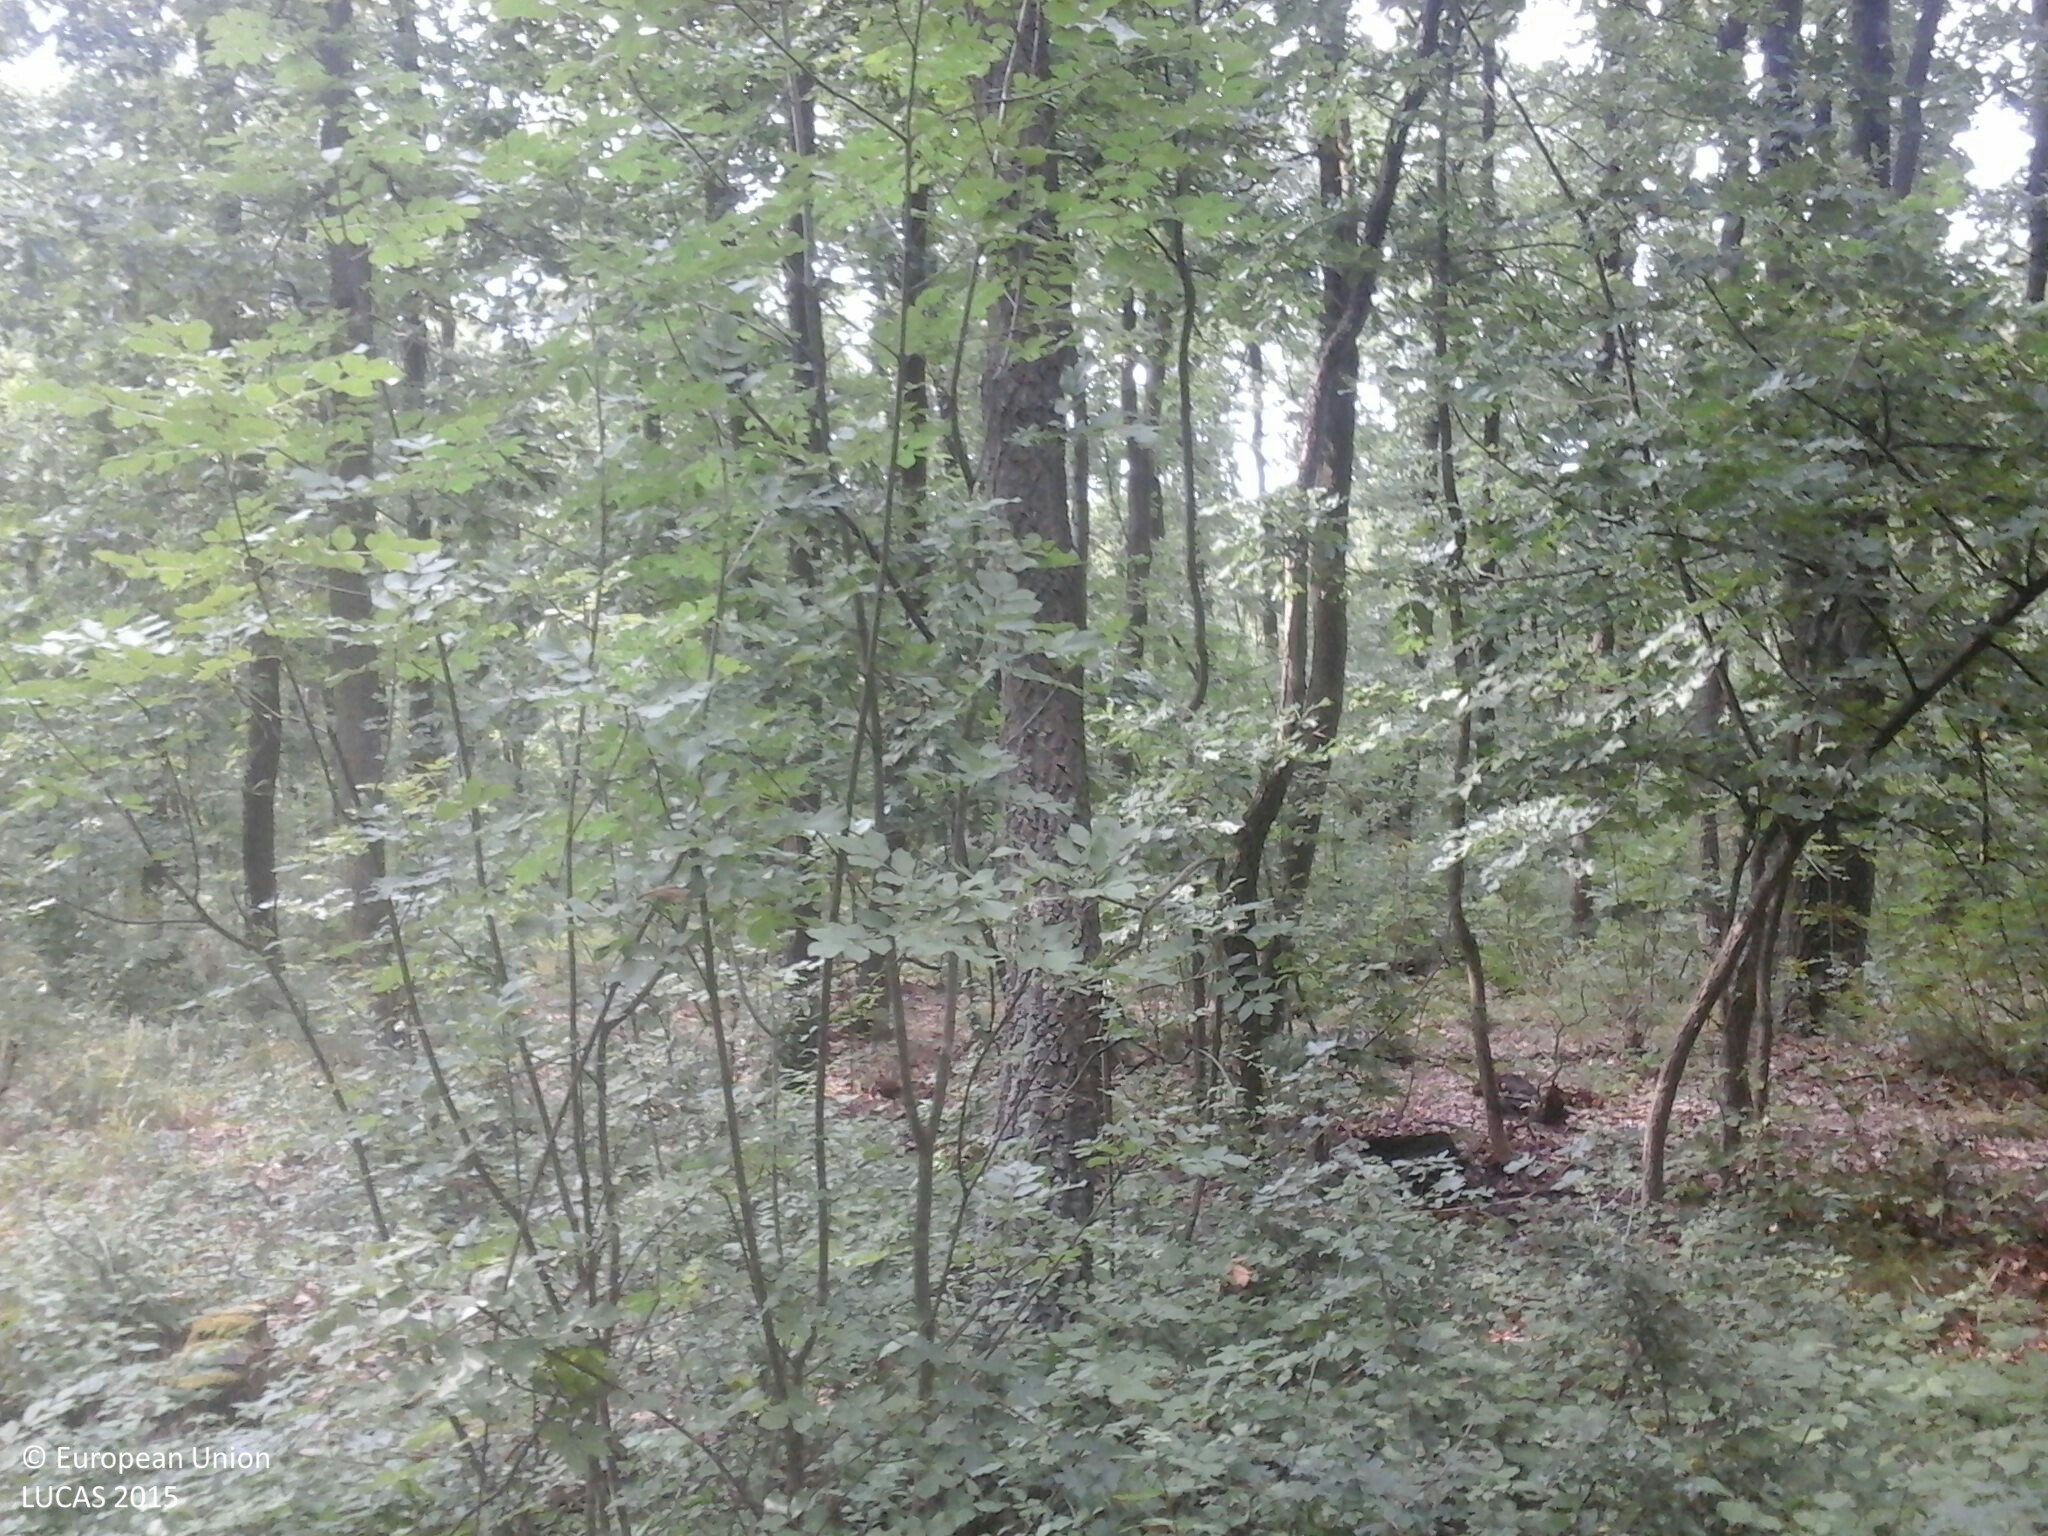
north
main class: Woodland
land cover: Broadleaved woodland
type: acidophilous oak and oak-birch forest
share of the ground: > 75 %
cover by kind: broadleaved forest trees 95 %, shrubs 5 %
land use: Forestry
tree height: > 5 m
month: July
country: HU
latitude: 46.9186
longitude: 17.7682
